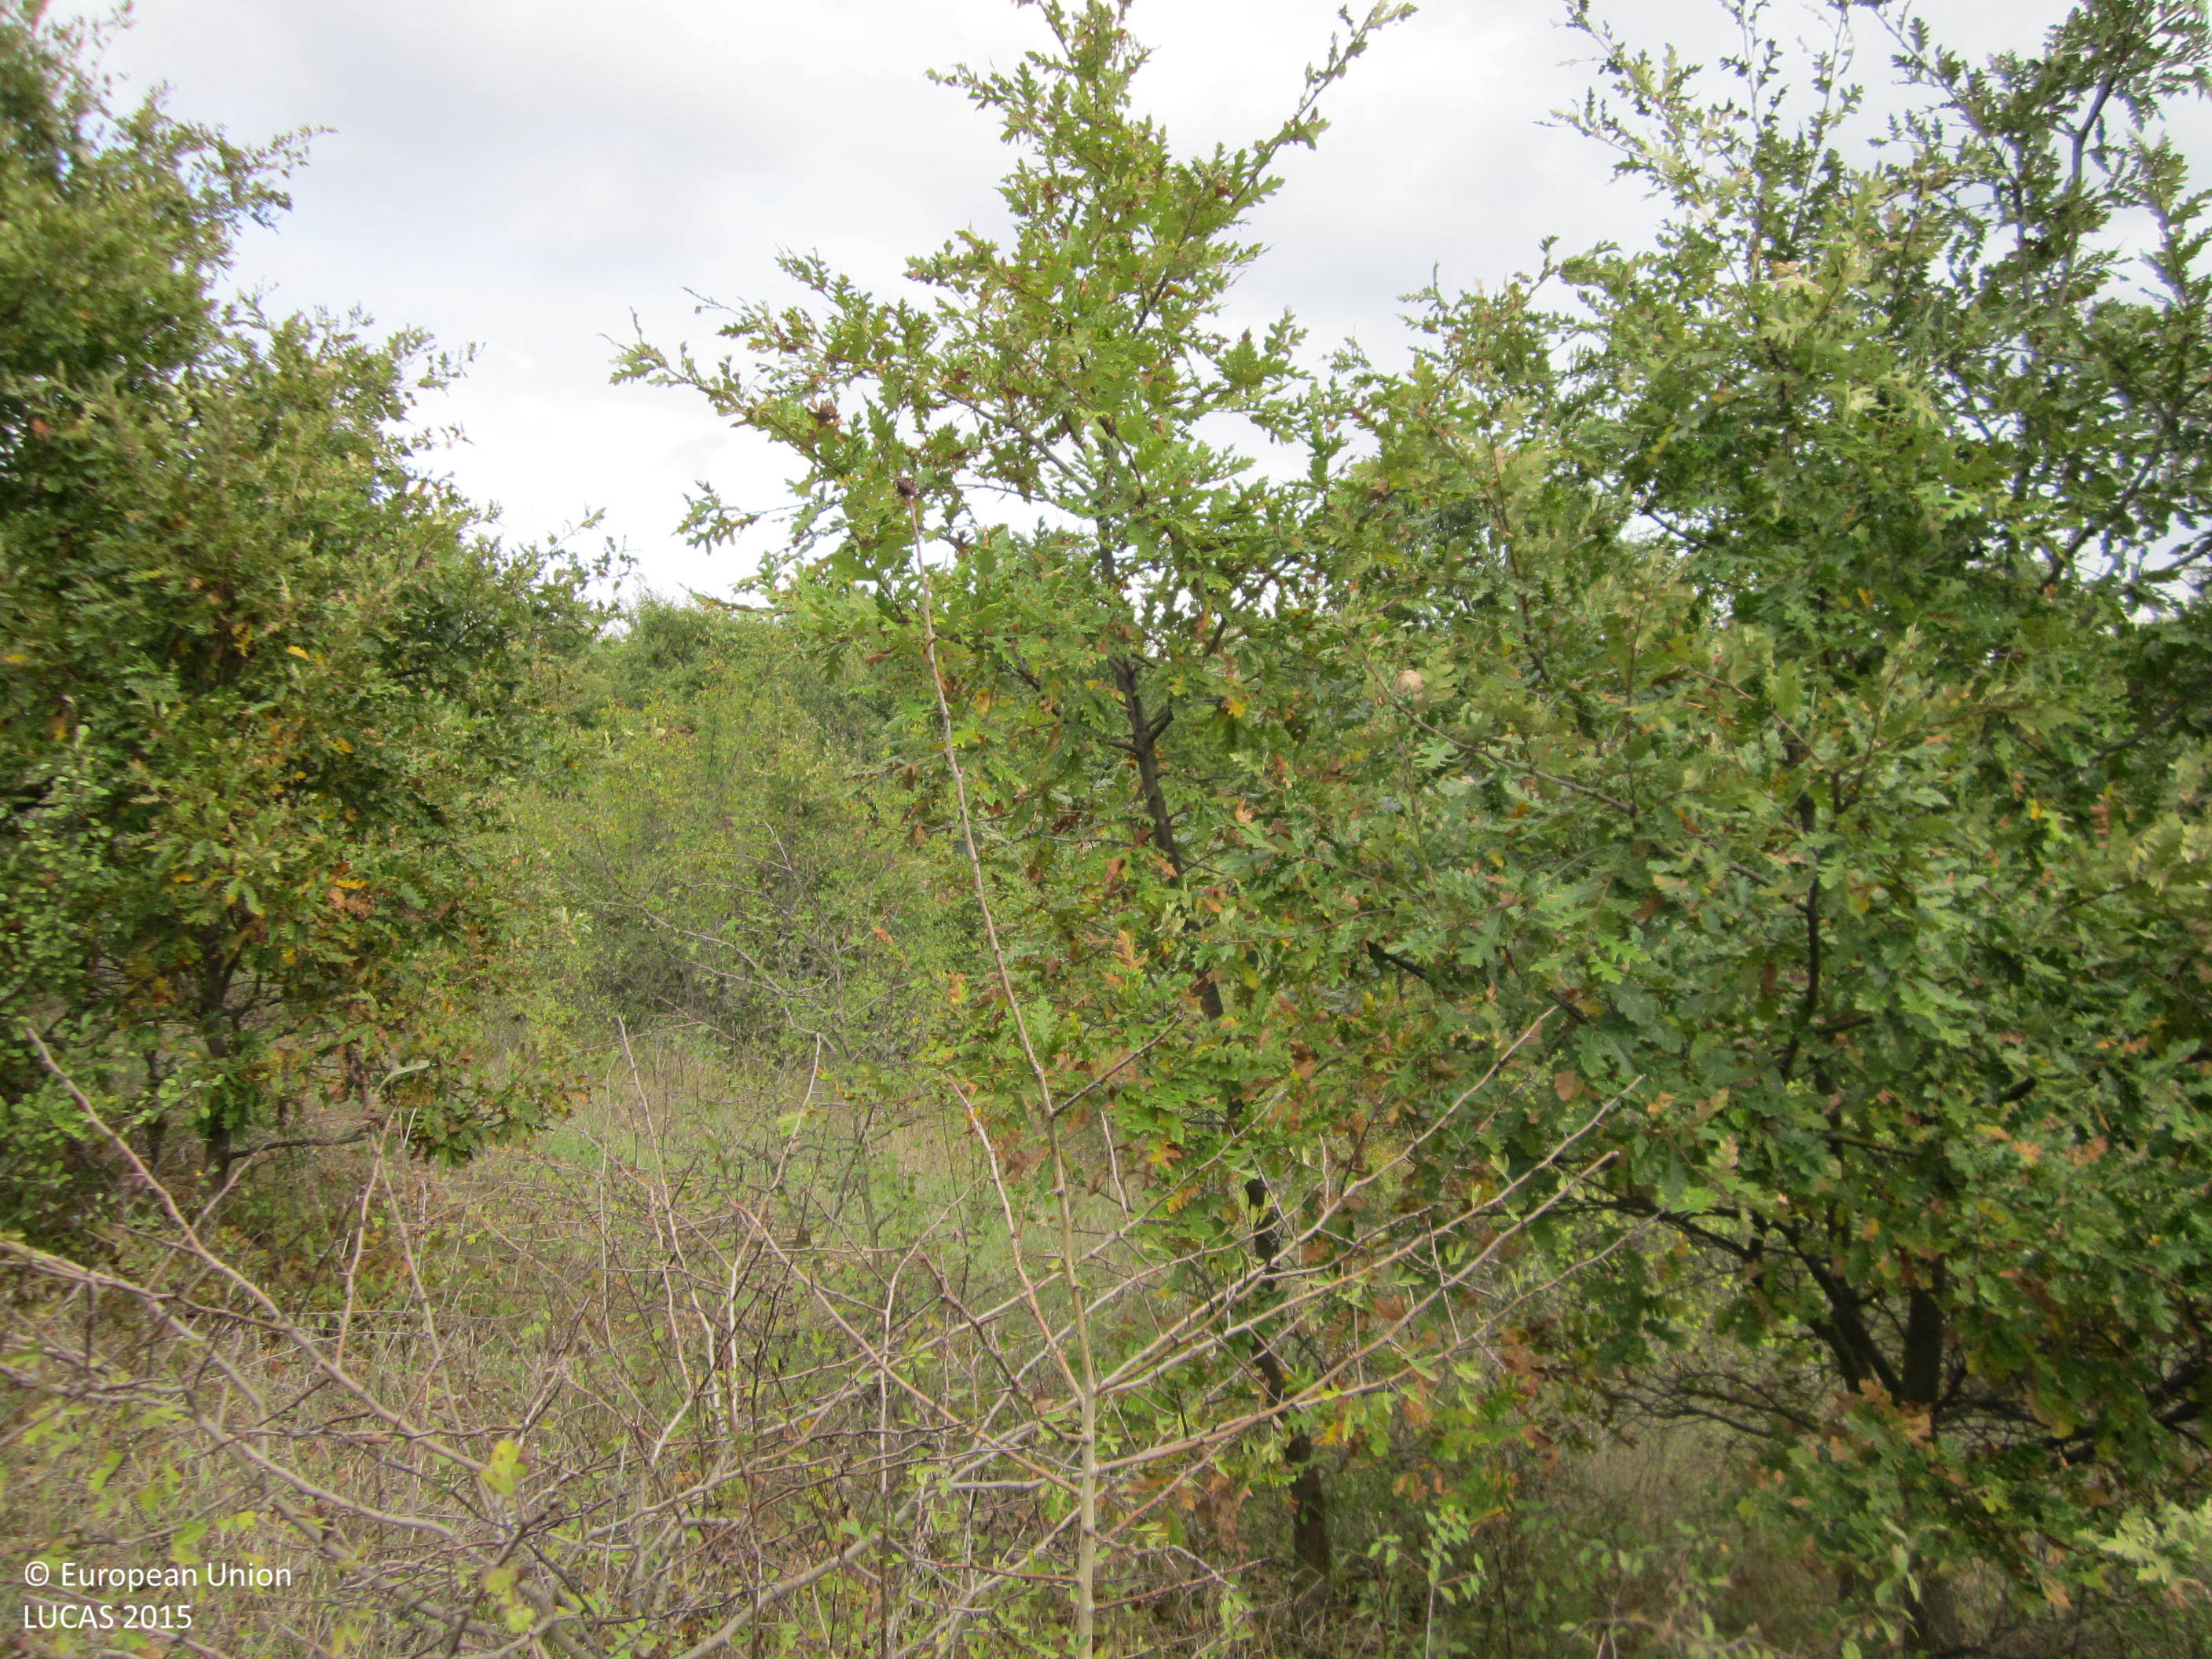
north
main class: Shrubland
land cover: Shrubland with sparse tree cover
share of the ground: 25 - 50 %
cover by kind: herbaceous plants 50 %, shrubs 45 %, broadleaved forest trees 5 %
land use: Semi-natural and natural areas not in use
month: October
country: BG
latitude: 42.3523
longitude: 26.9642
